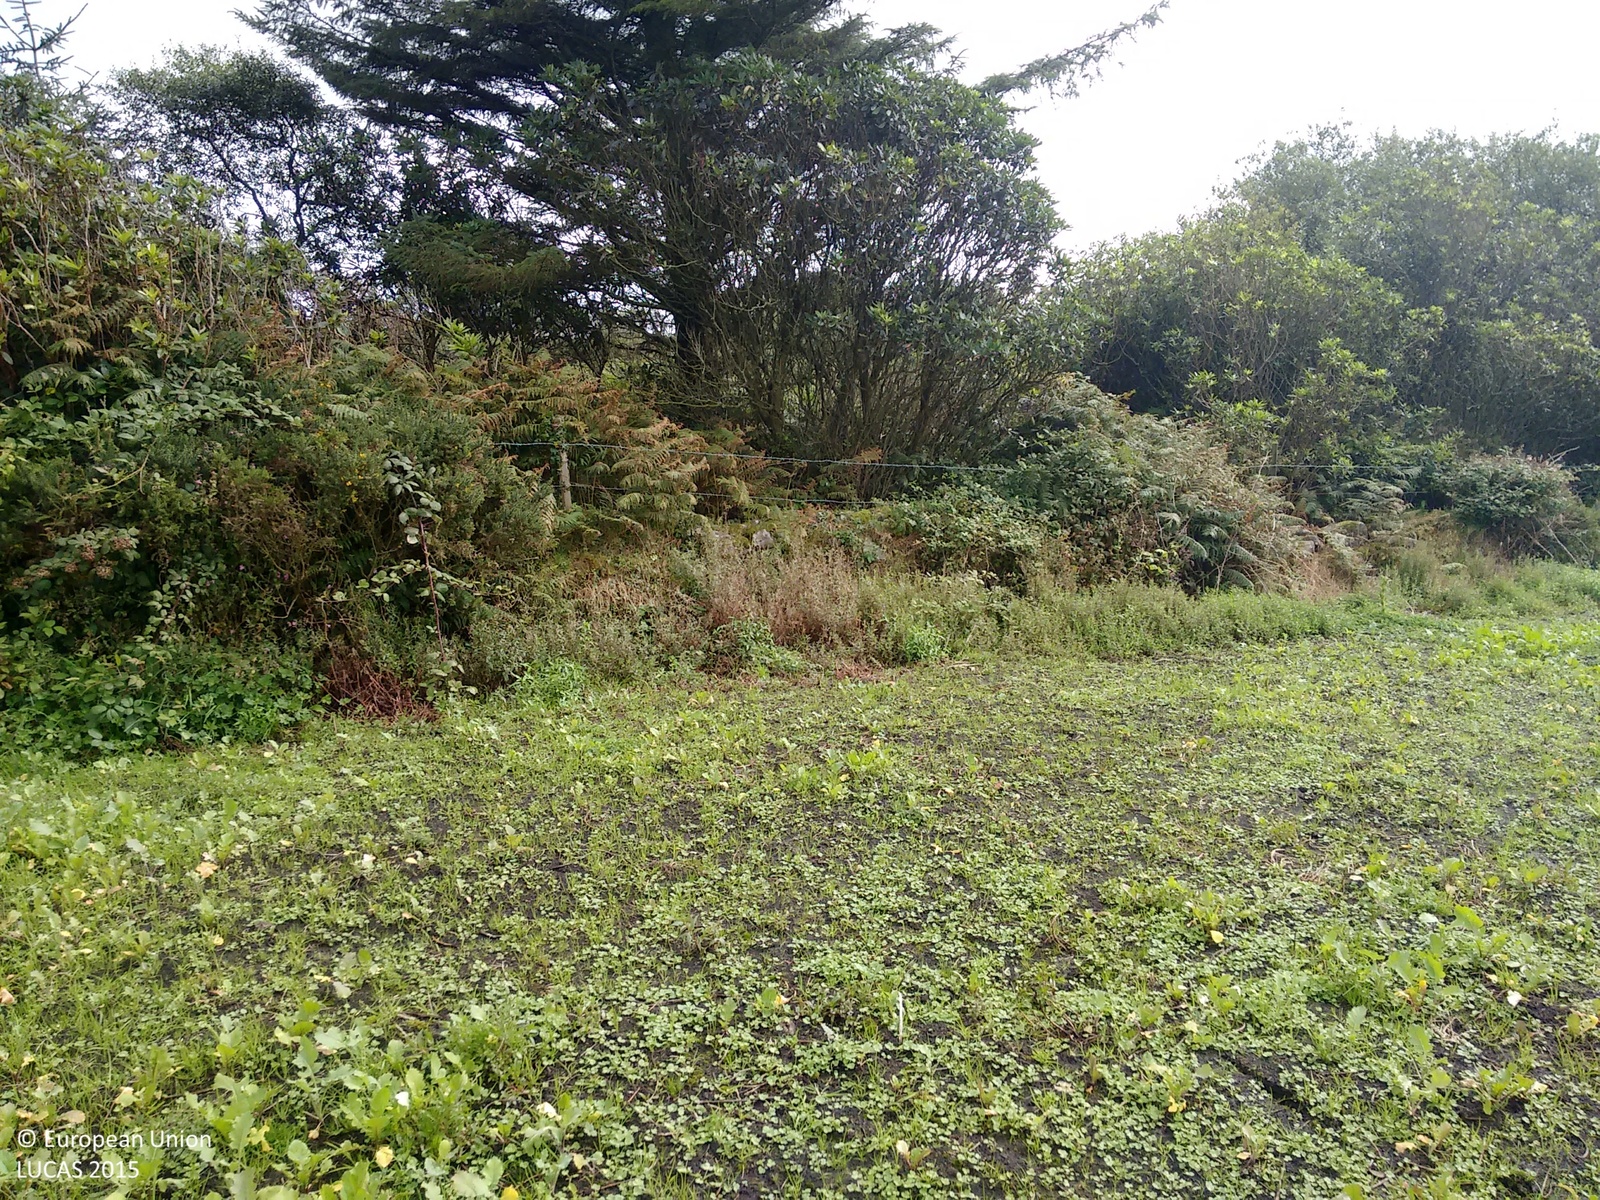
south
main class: Cropland
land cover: Other root crops
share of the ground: > 75 %
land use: Agriculture (excluding fallow land and kitchen gardens)
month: August
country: GB
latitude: 50.1544
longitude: -5.5383
